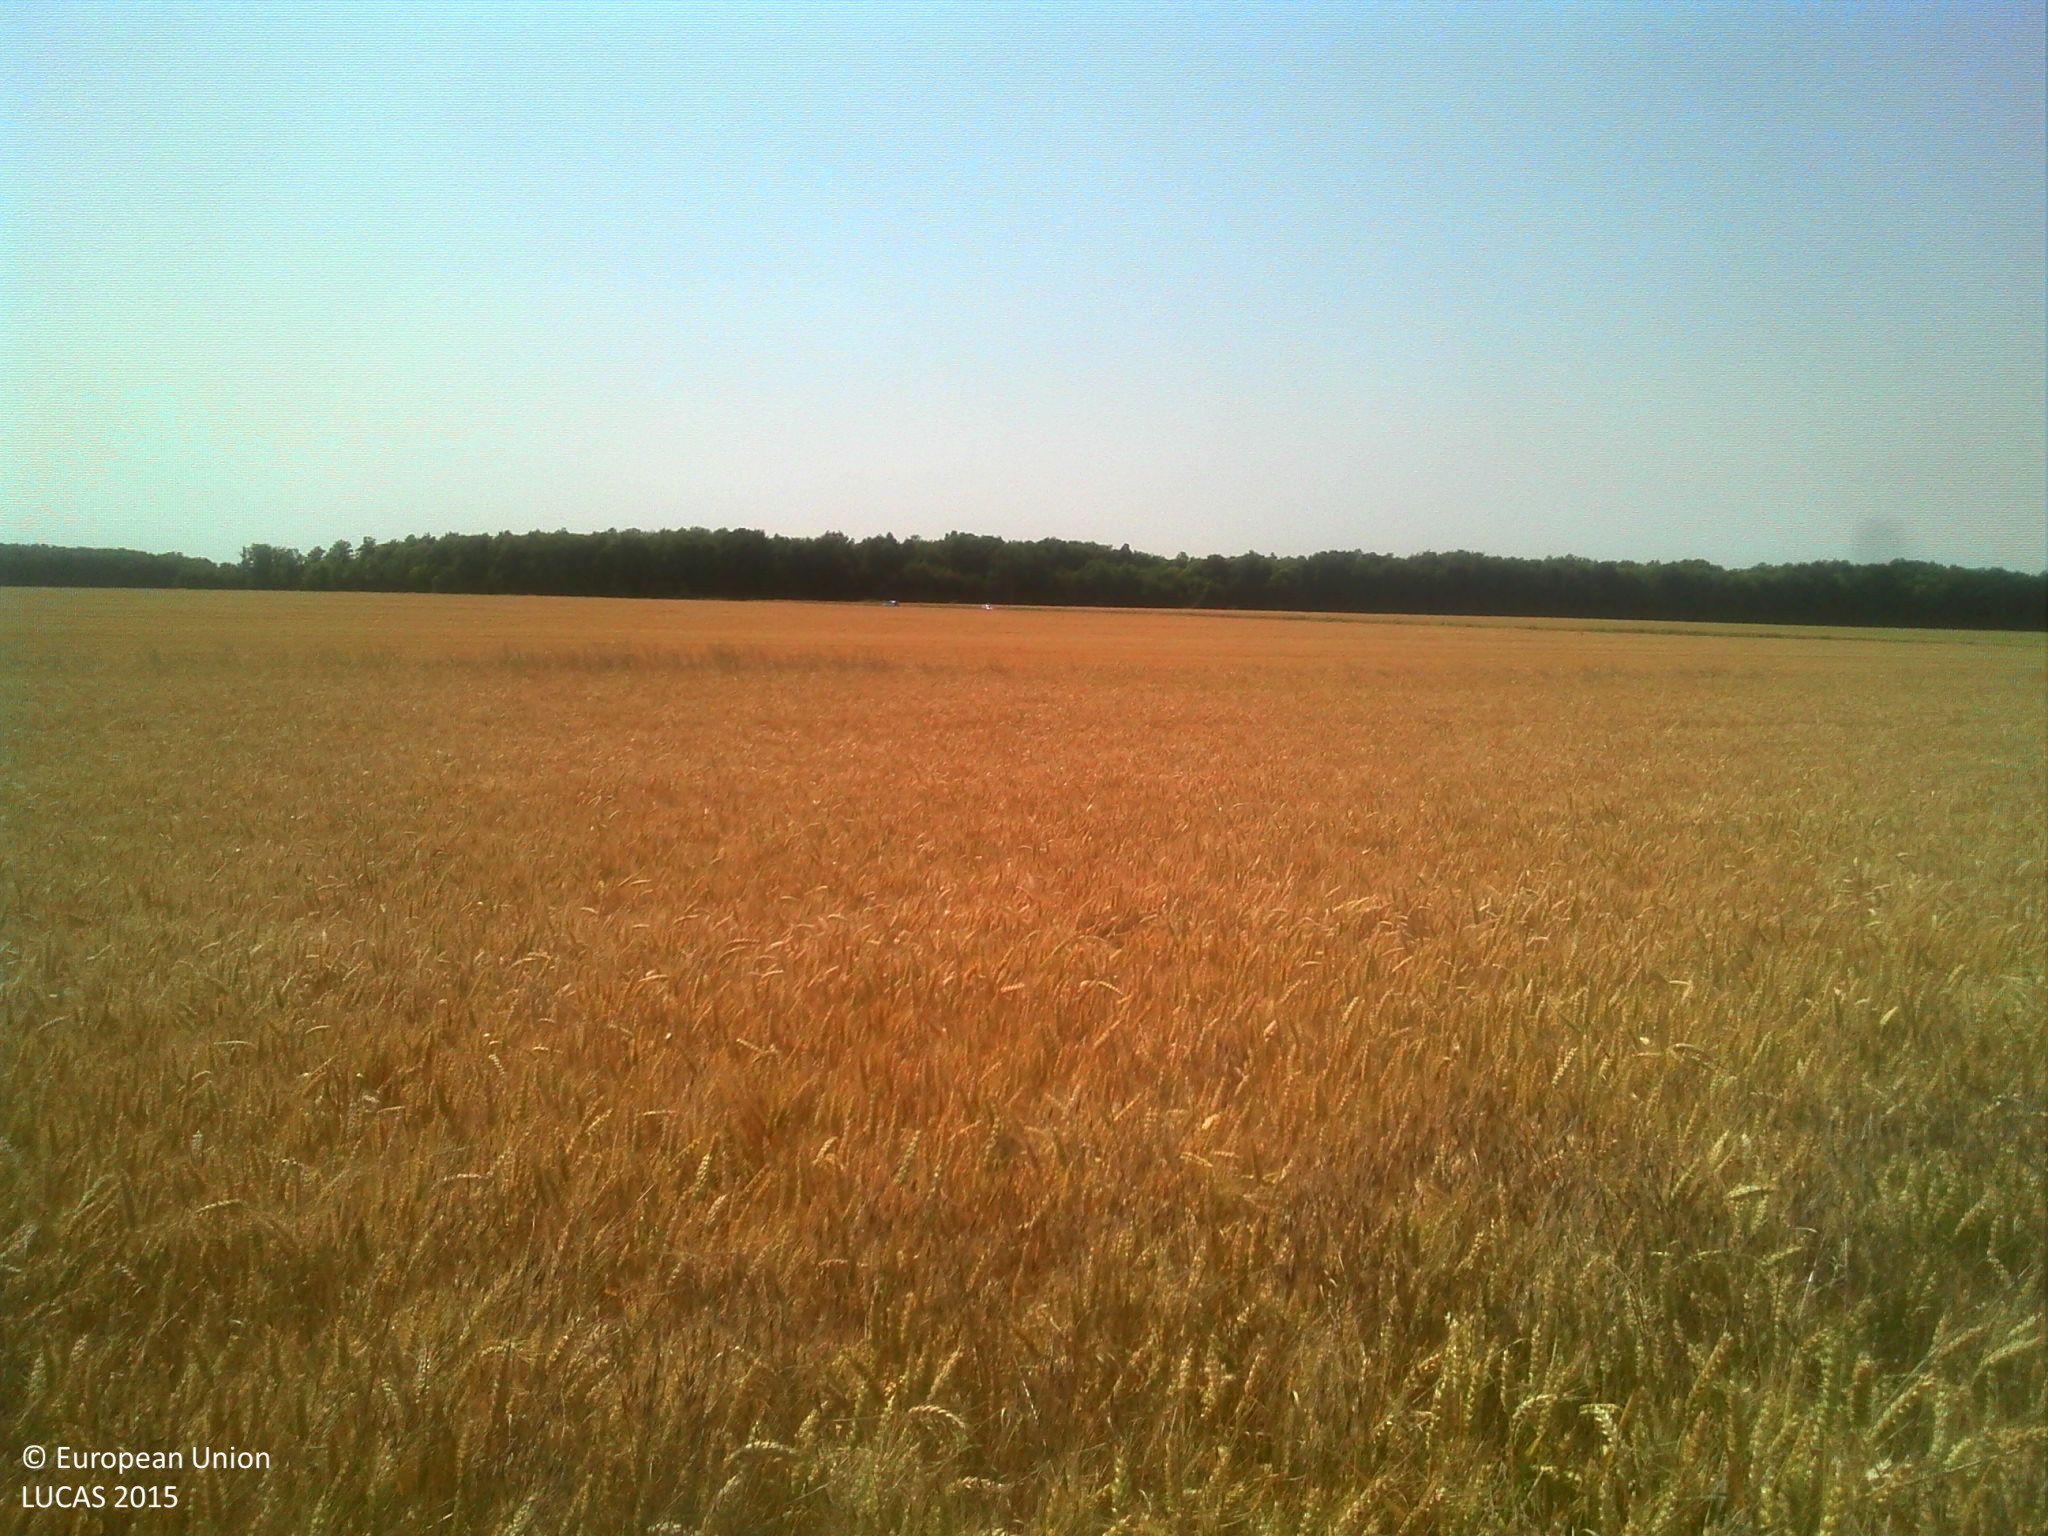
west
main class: Cropland
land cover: Common wheat
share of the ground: > 75 %
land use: Agriculture (excluding fallow land and kitchen gardens)
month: July
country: FR
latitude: 48.7563
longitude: 1.1795
